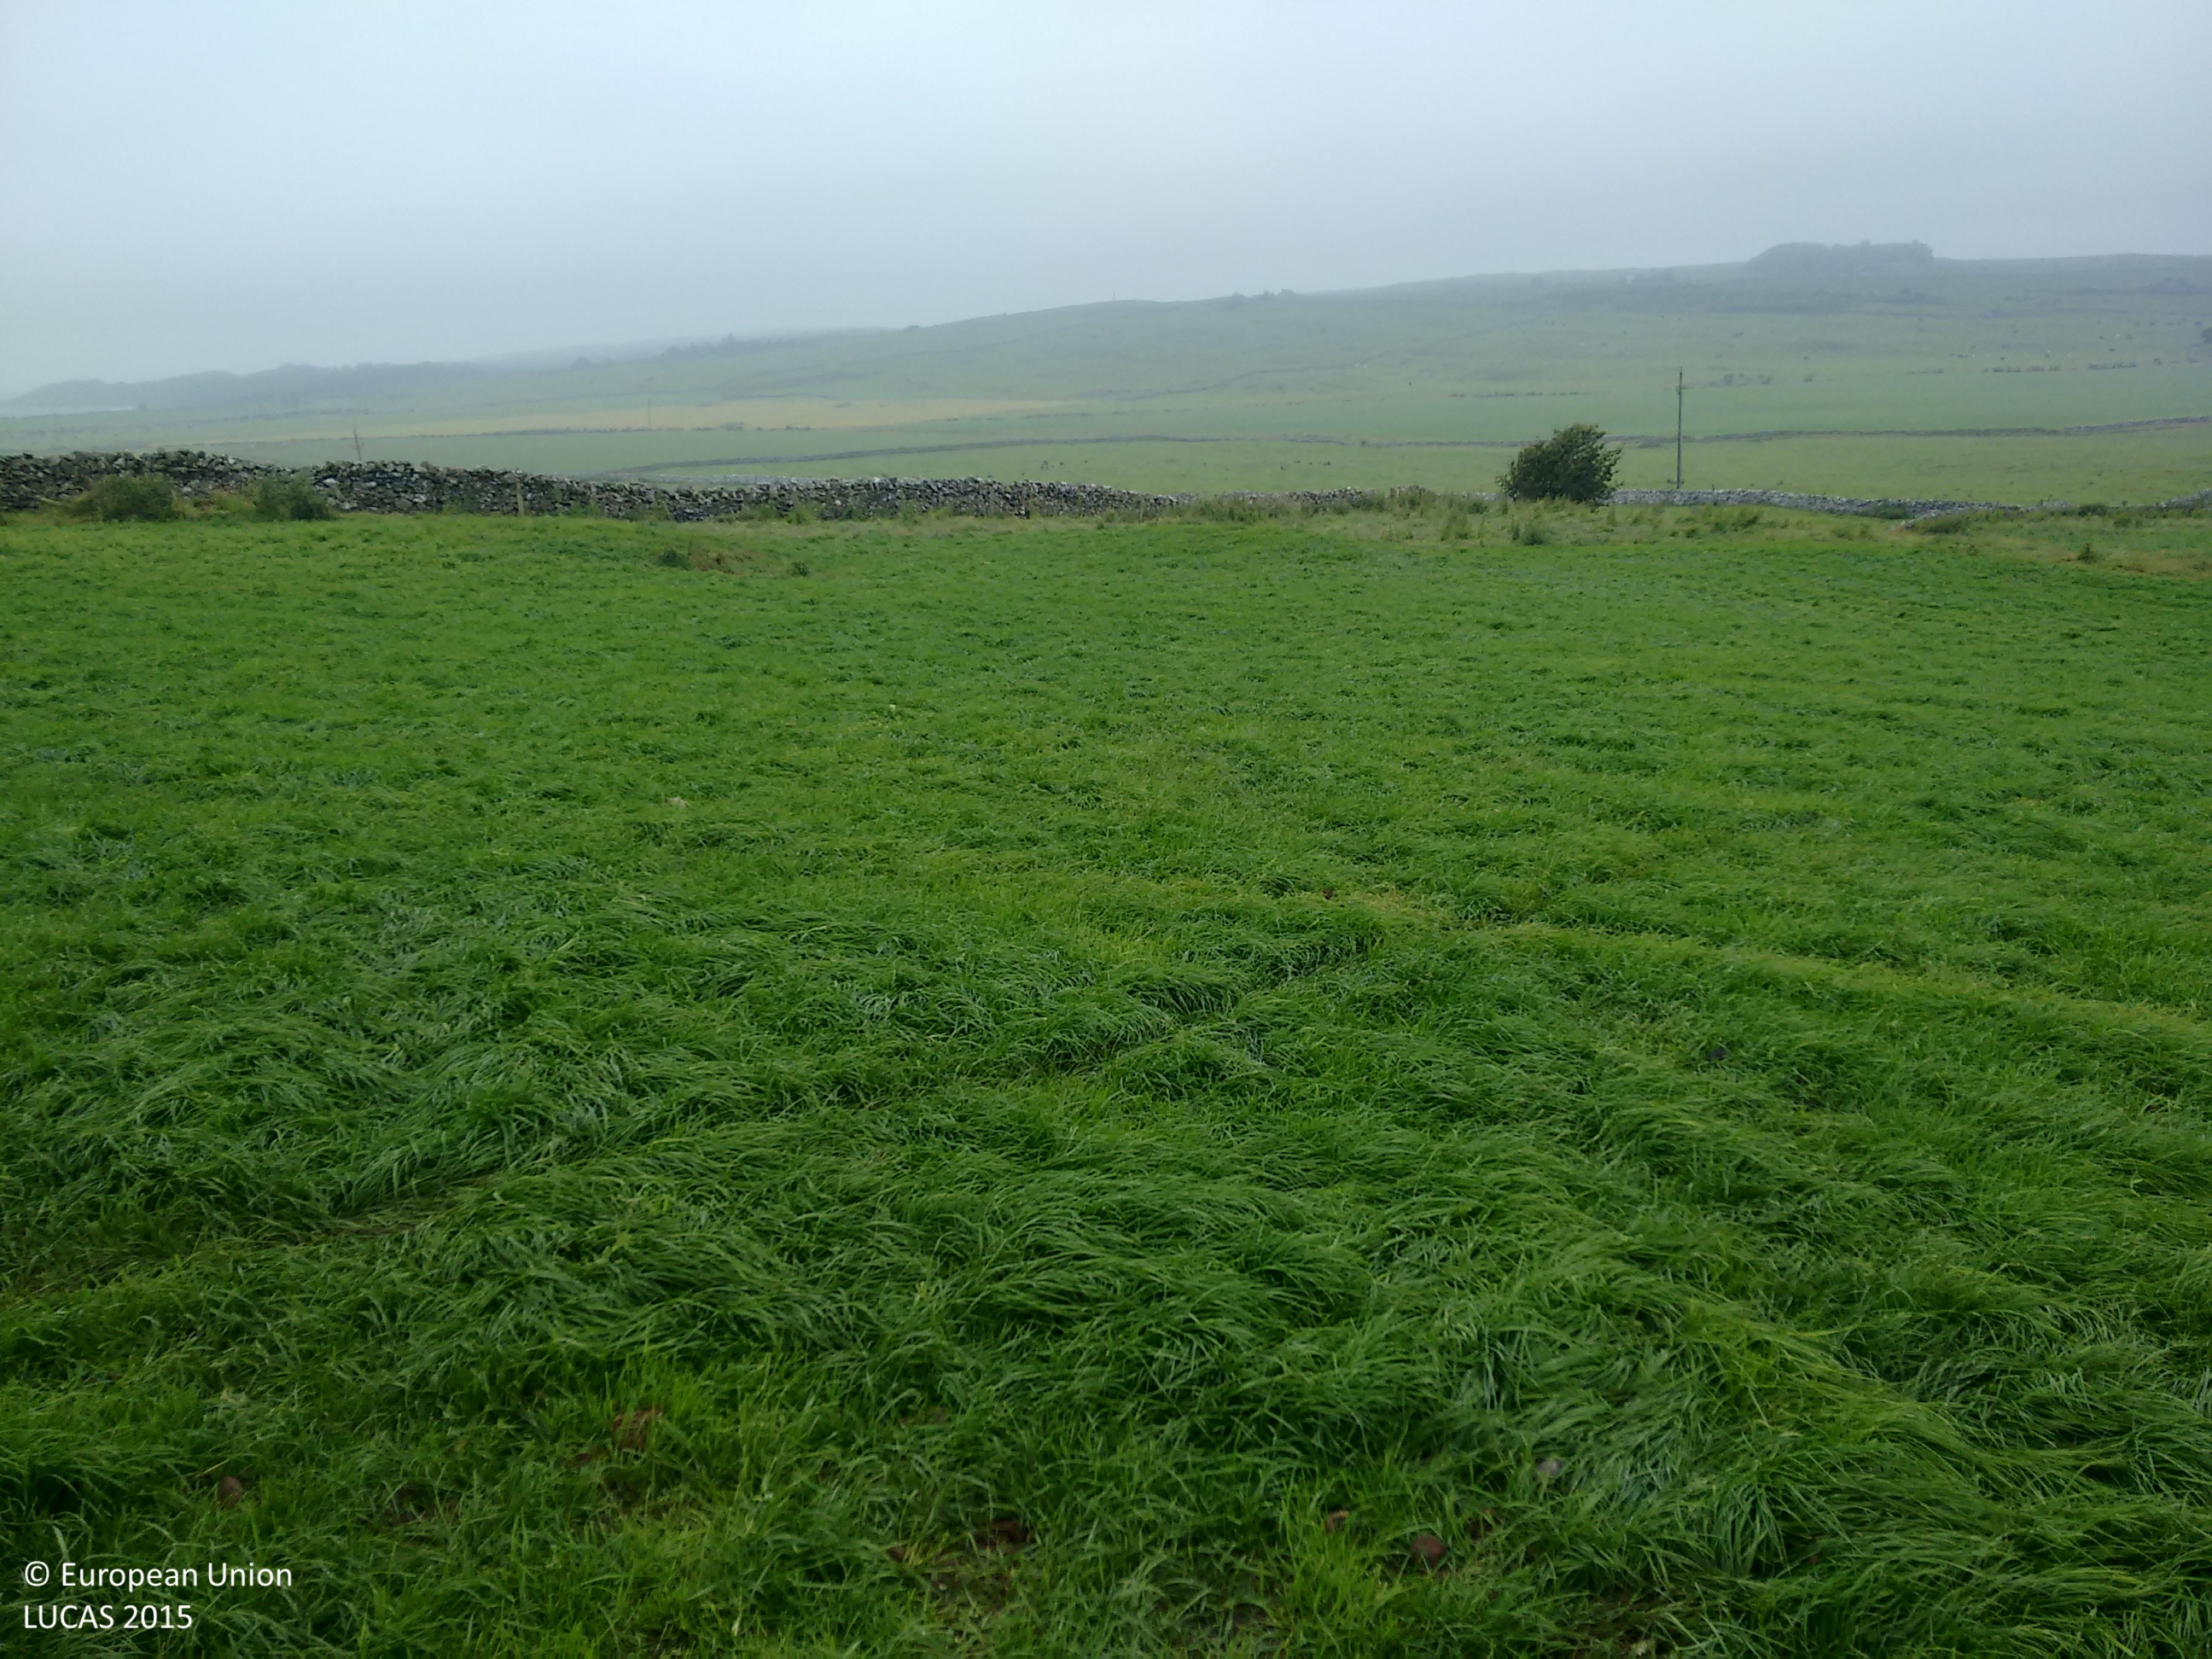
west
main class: Grassland
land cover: Grassland without tree/shrub cover
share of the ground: > 75 %
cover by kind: herbaceous plants 100 %
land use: Agriculture (excluding fallow land and kitchen gardens)
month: July
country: GB
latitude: 54.7994
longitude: -4.1091
